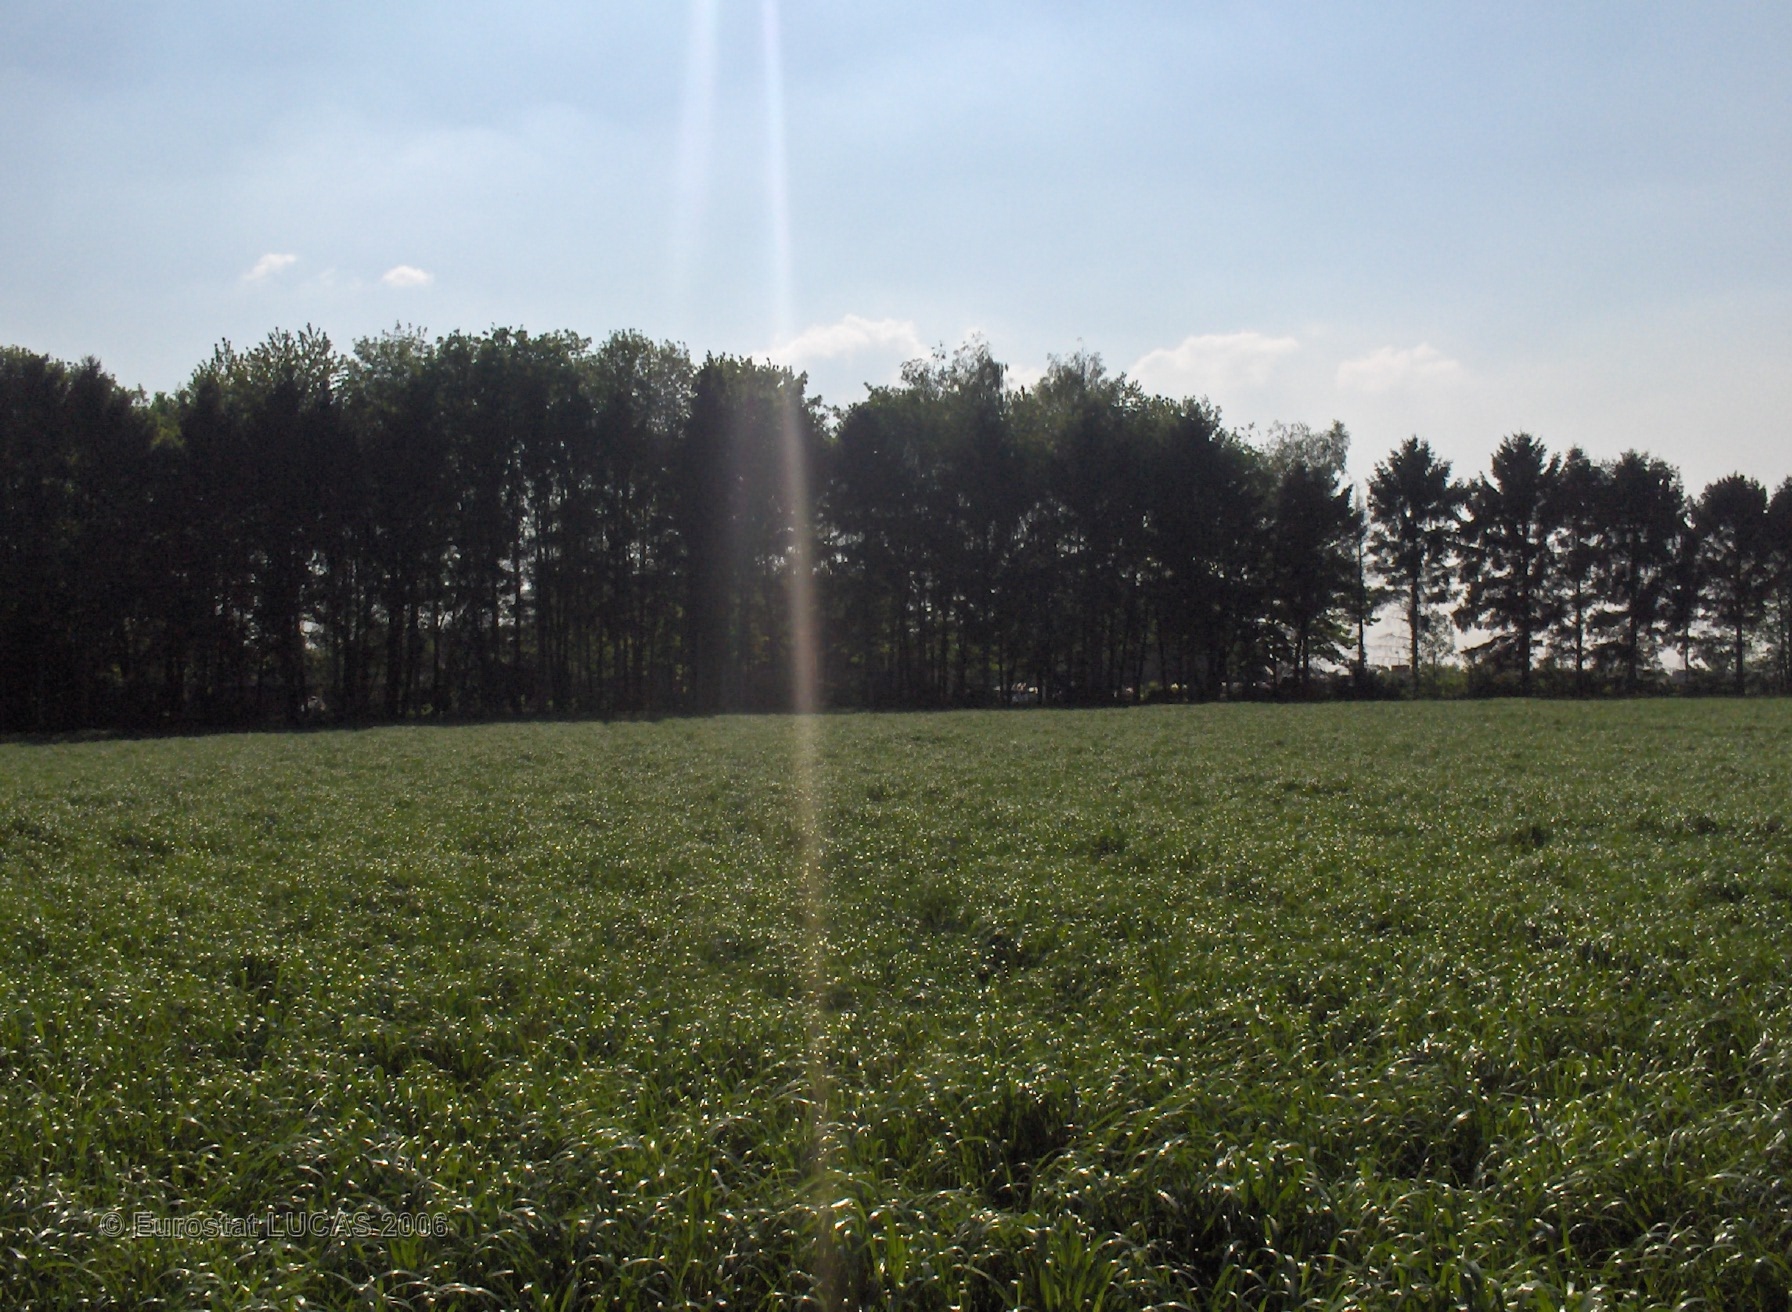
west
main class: Grassland
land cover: Grassland without tree/shrub cover
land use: Agriculture (excluding fallow land and kitchen gardens)
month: May
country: BE
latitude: 50.4655
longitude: 4.4874
